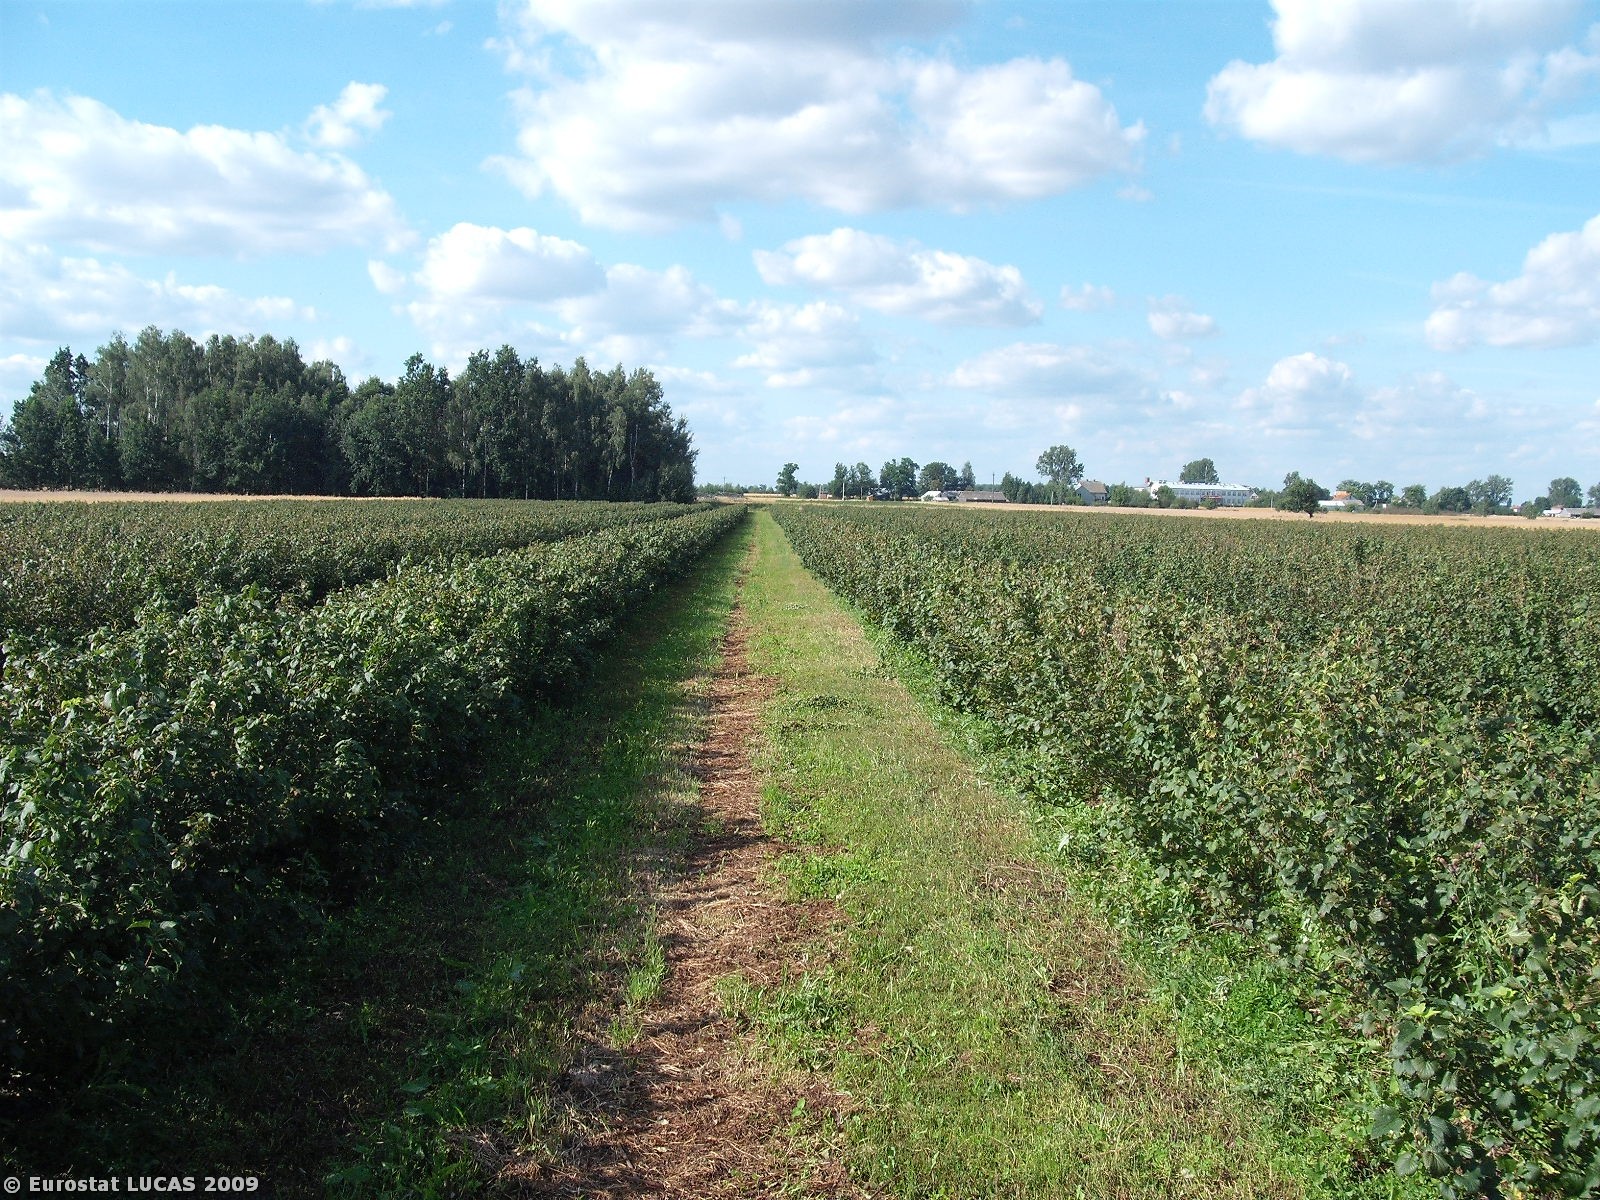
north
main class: Cropland
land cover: Other fruit trees and berries
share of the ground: 50 - 75 %
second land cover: Grassland with sparse tree/shrub cover
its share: > 75 %
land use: Agriculture (excluding fallow land and kitchen gardens)
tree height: < 5 m
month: July
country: PL
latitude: 51.2030
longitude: 21.4575
